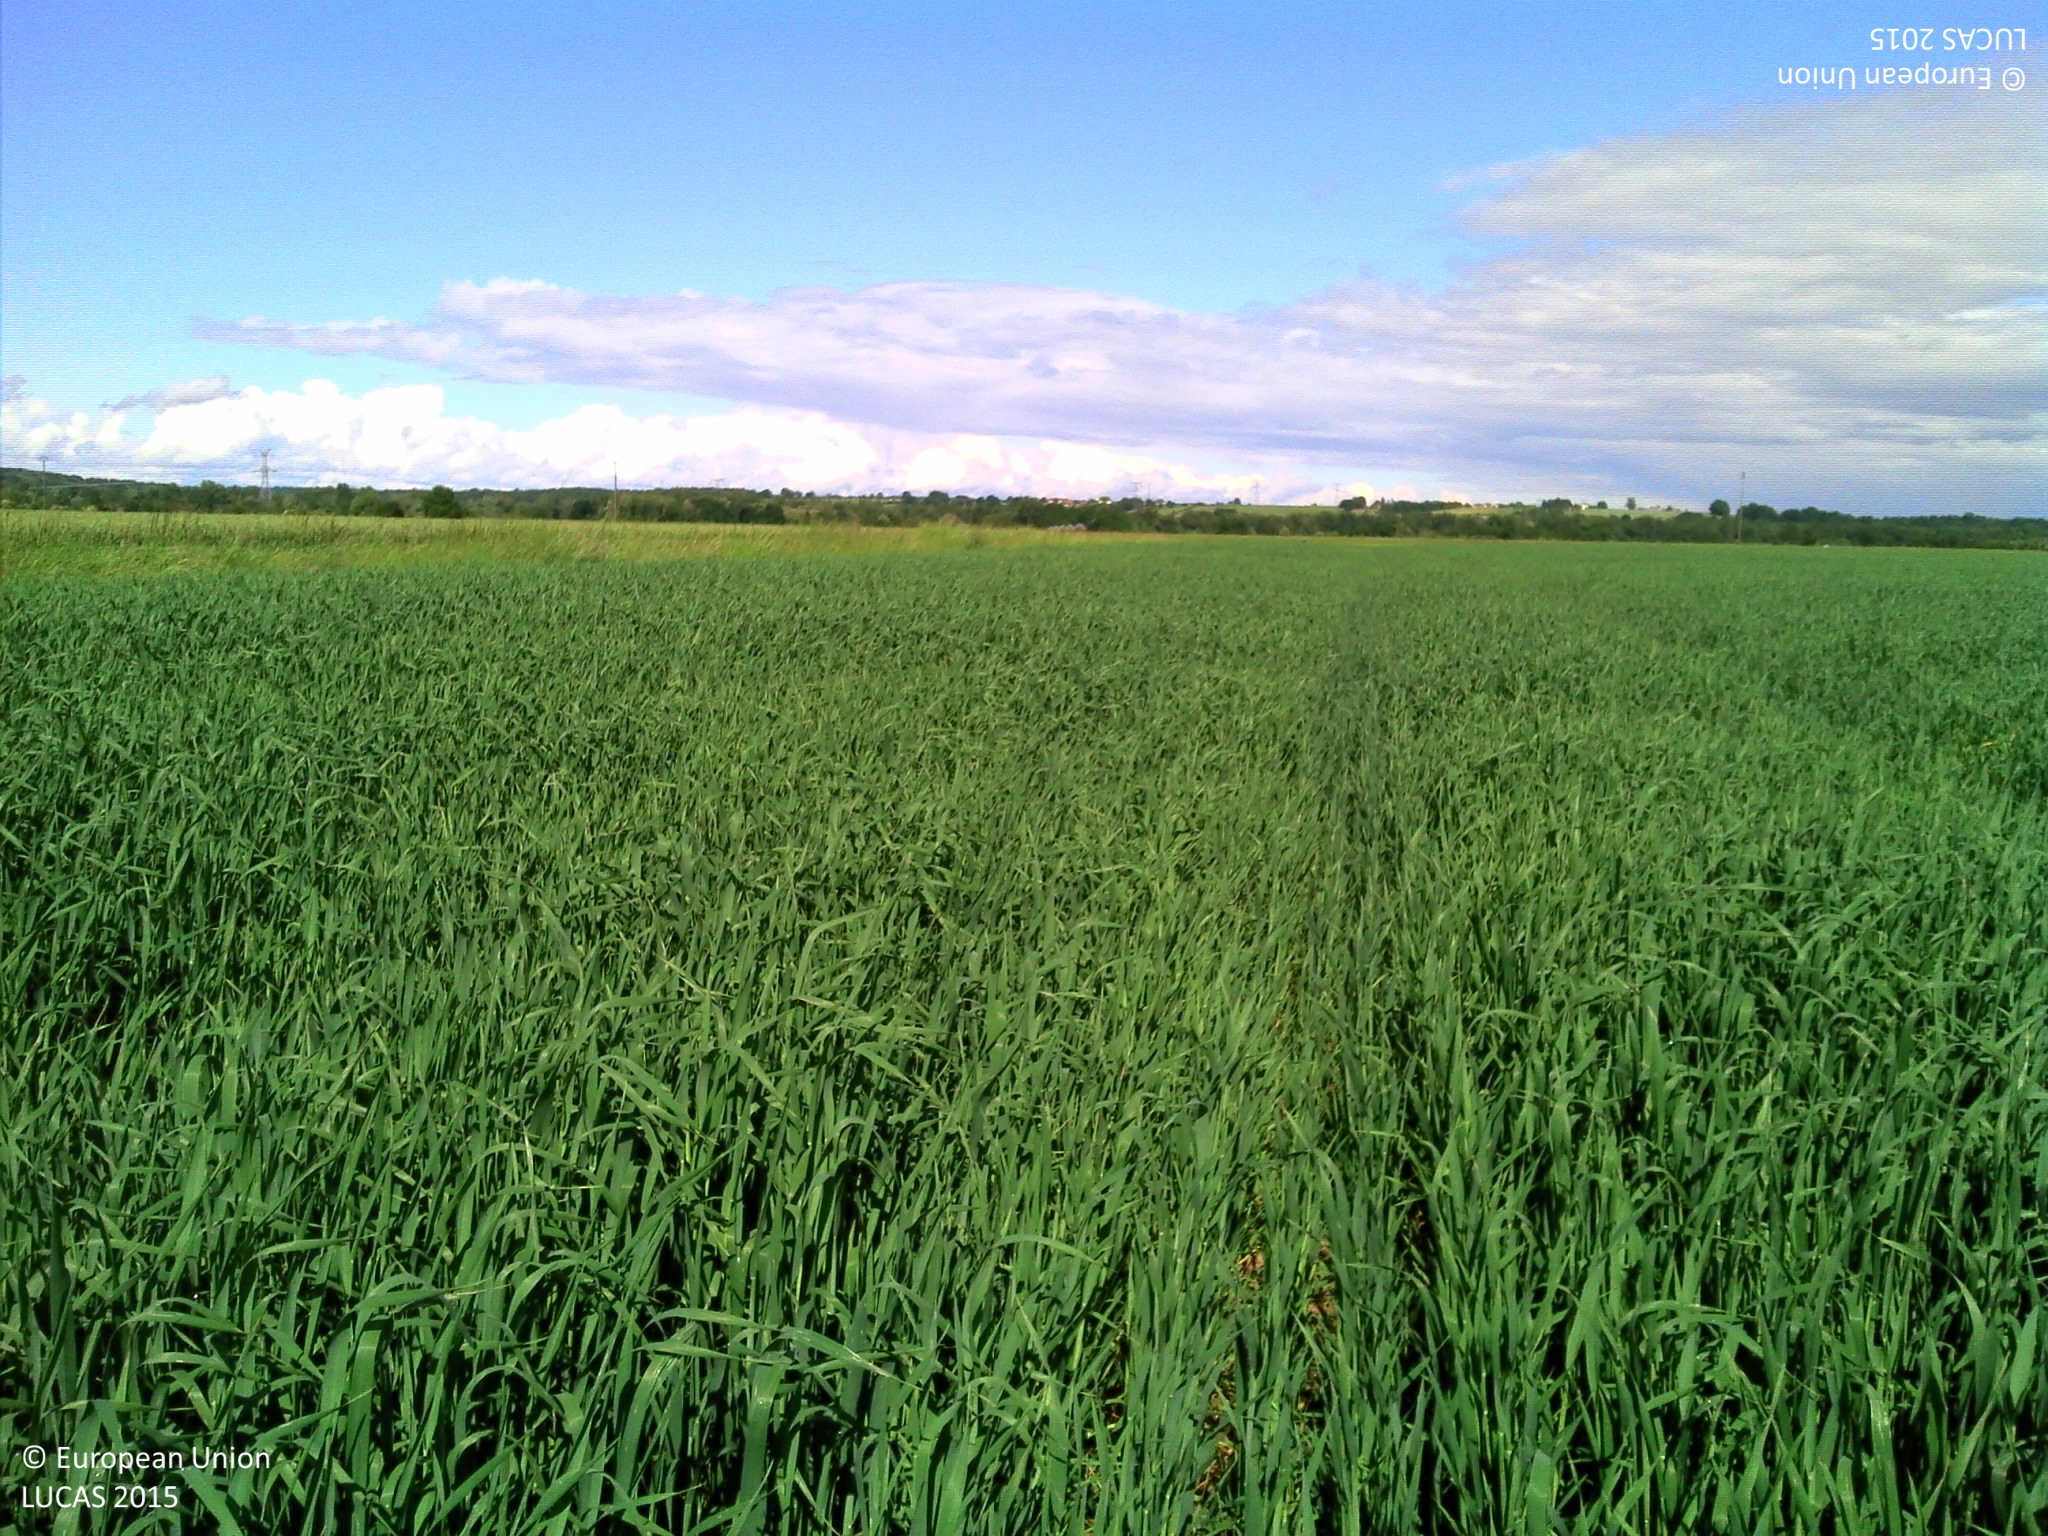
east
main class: Cropland
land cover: Oats
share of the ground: > 75 %
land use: Agriculture (excluding fallow land and kitchen gardens)
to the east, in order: Oats
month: May
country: FR
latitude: 47.4524
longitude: 2.8981
